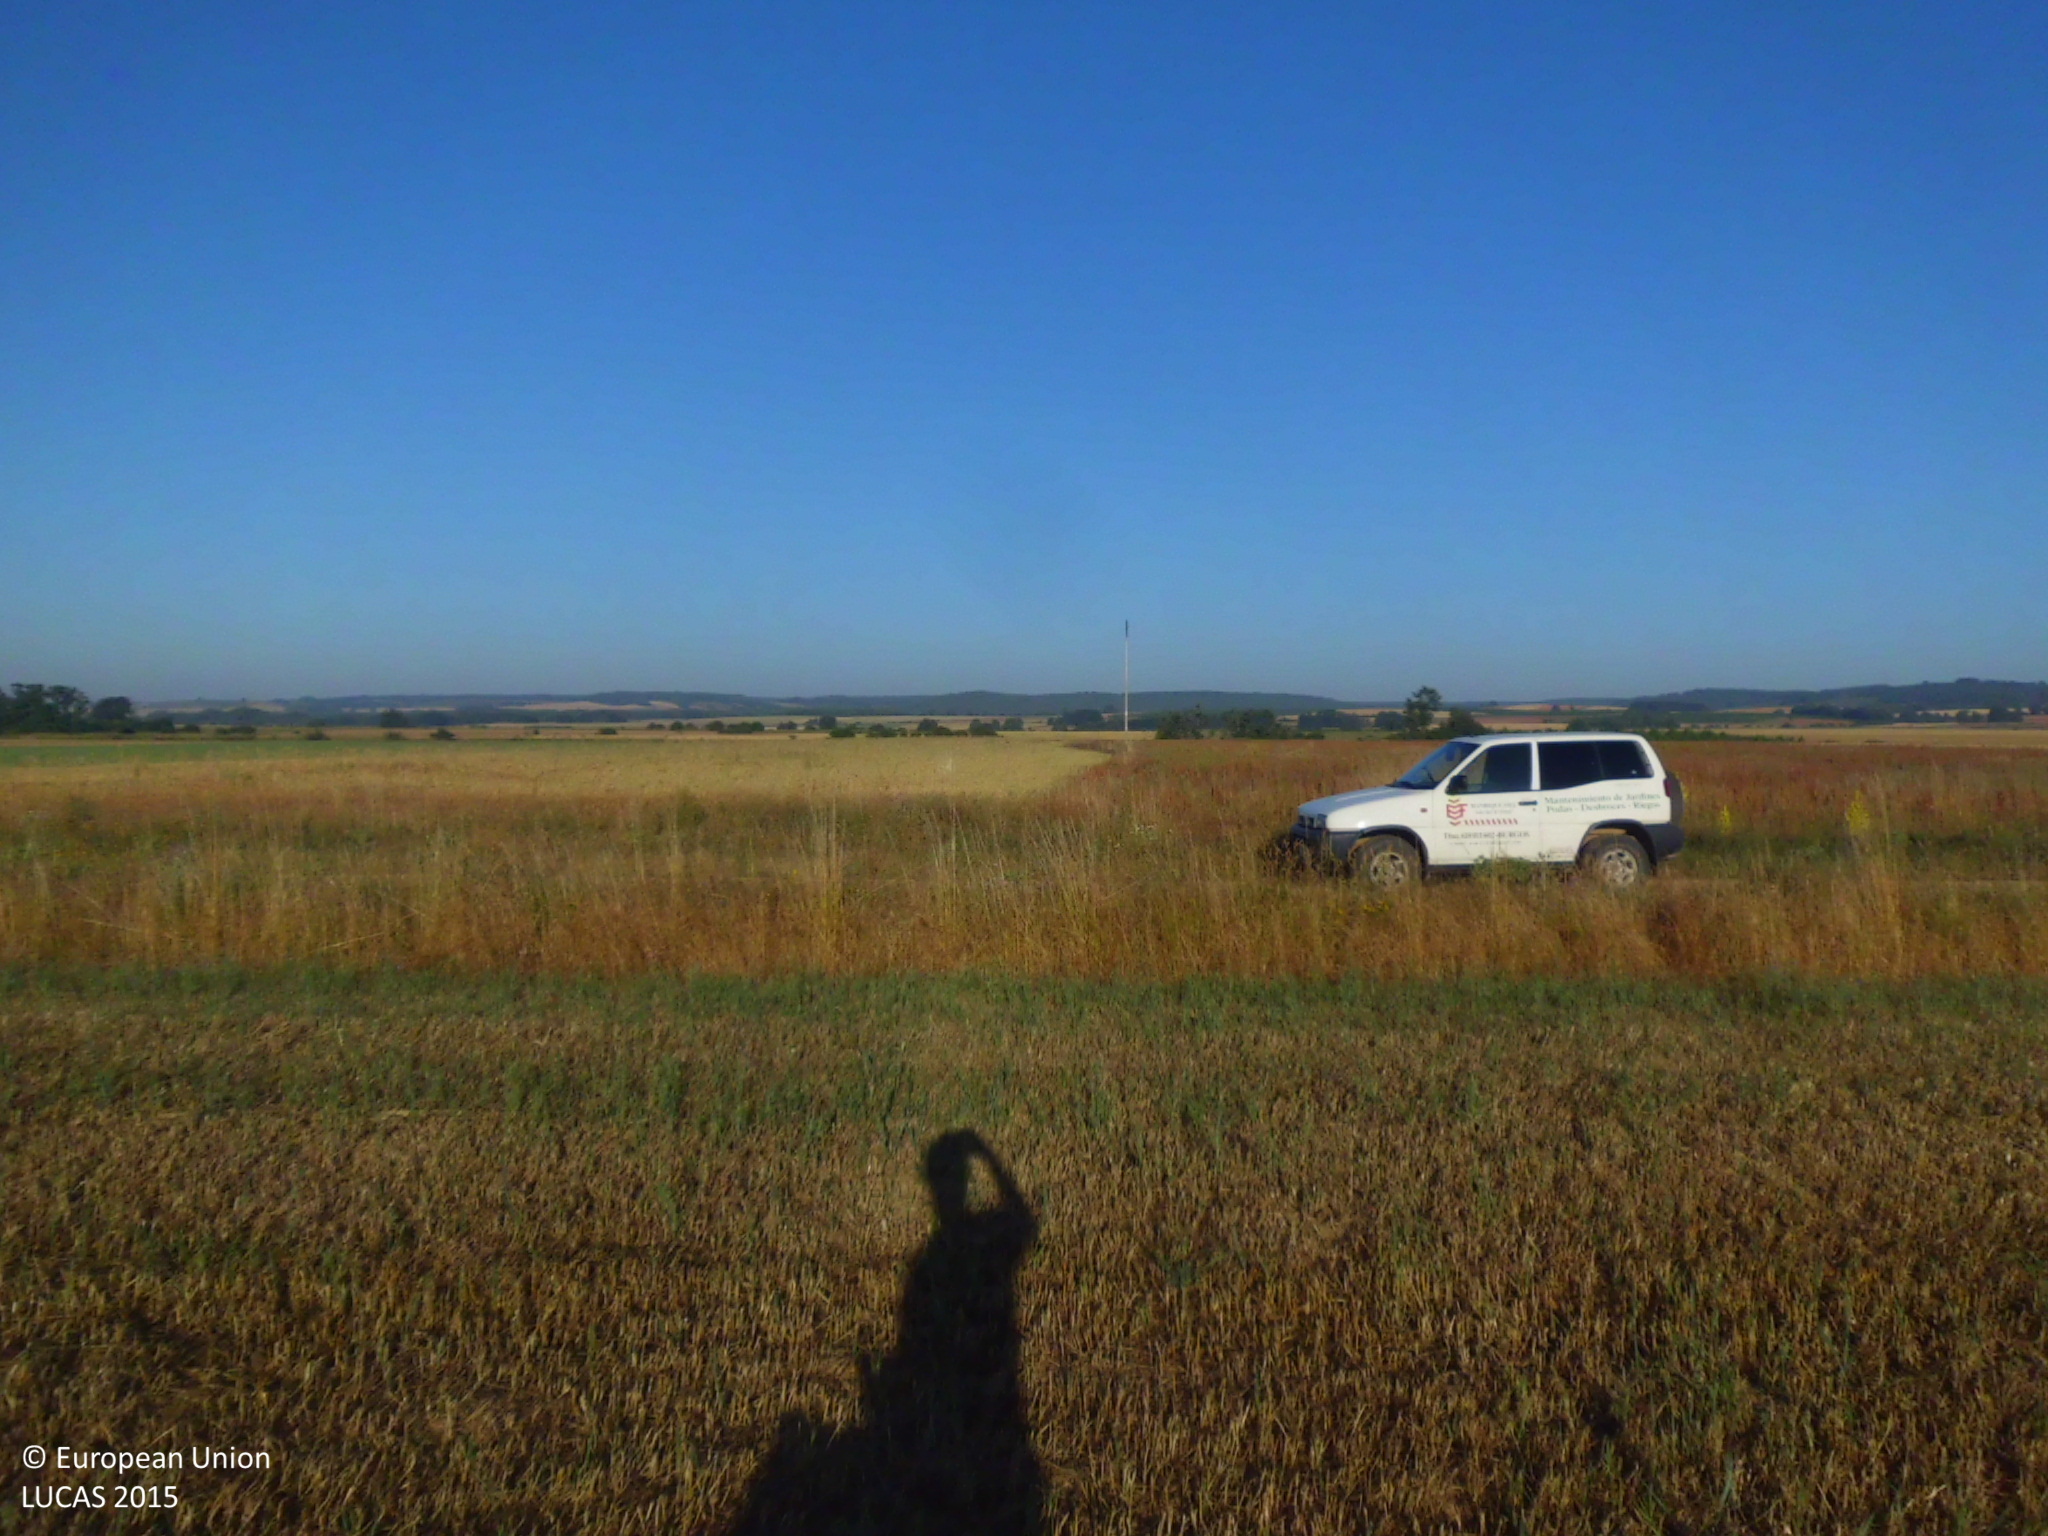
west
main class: Grassland
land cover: Spontaneously vegetated surfaces
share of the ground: 50 - 75 %
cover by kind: herbaceous plants 60 %, unconsolidated bare surface 40 %
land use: Fallow land
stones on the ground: < 10 %
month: June
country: ES
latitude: 42.6440
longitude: -5.0276
